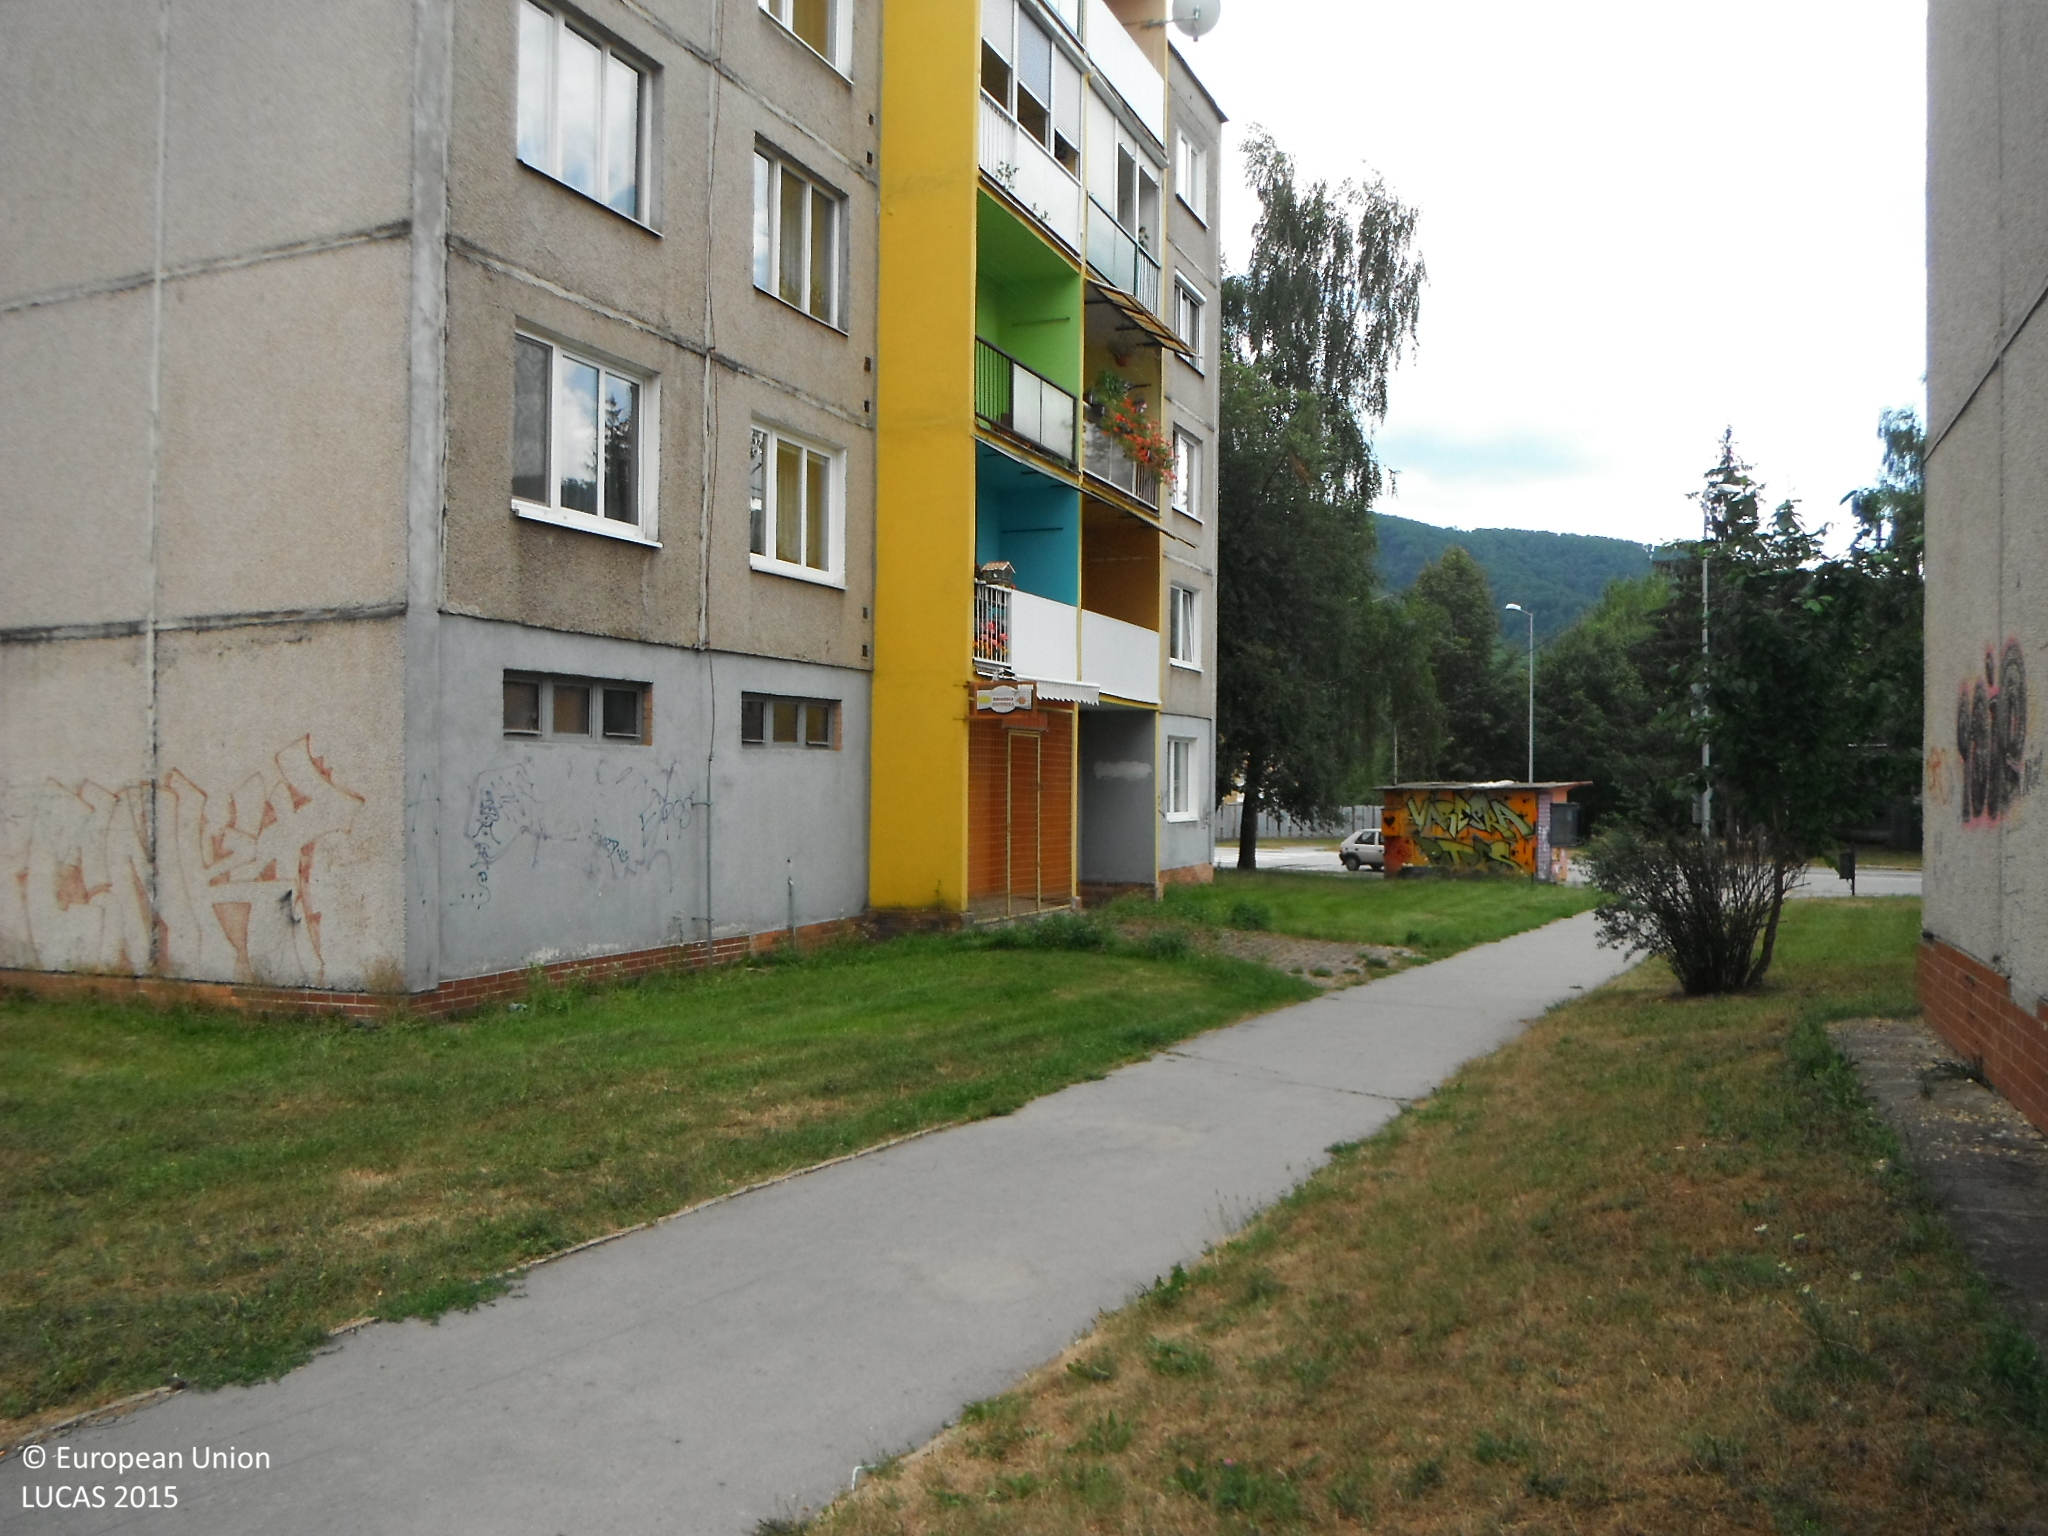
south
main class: Grassland
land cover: Grassland without tree/shrub cover
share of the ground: 25 - 50 %
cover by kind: herbaceous plants 50 %
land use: Residential
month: July
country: SK
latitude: 48.6811
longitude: 20.1228
